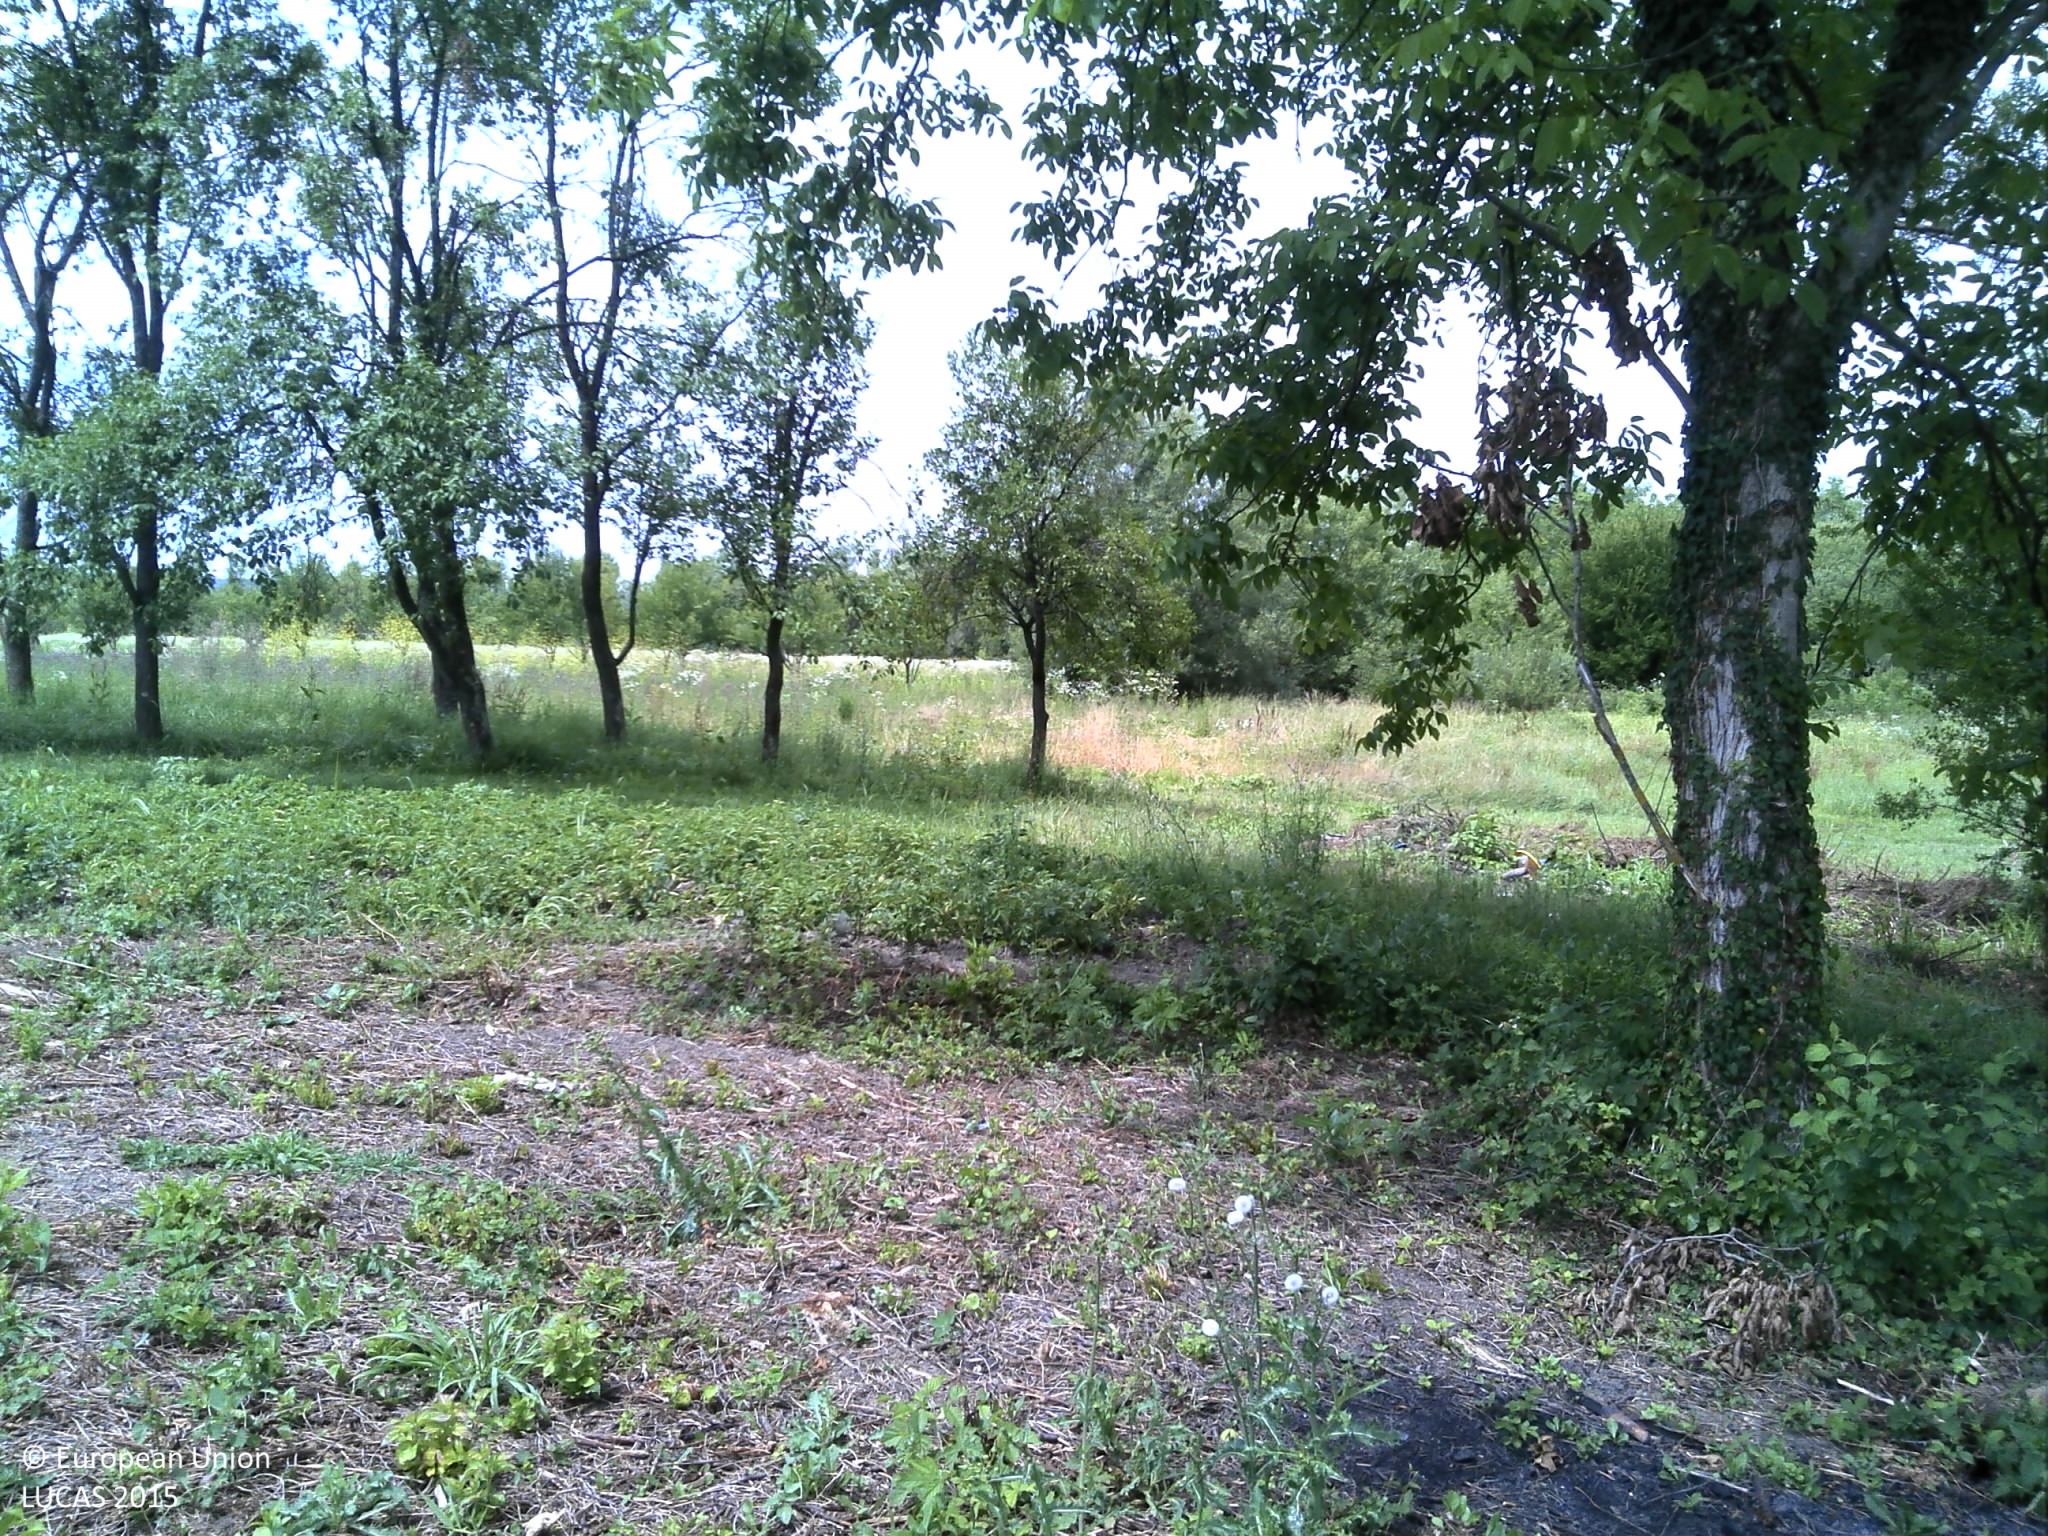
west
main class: Cropland
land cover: Vineyards
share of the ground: 50 - 75 %
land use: Kitchen garden
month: June
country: HR
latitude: 45.0481
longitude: 17.8604
